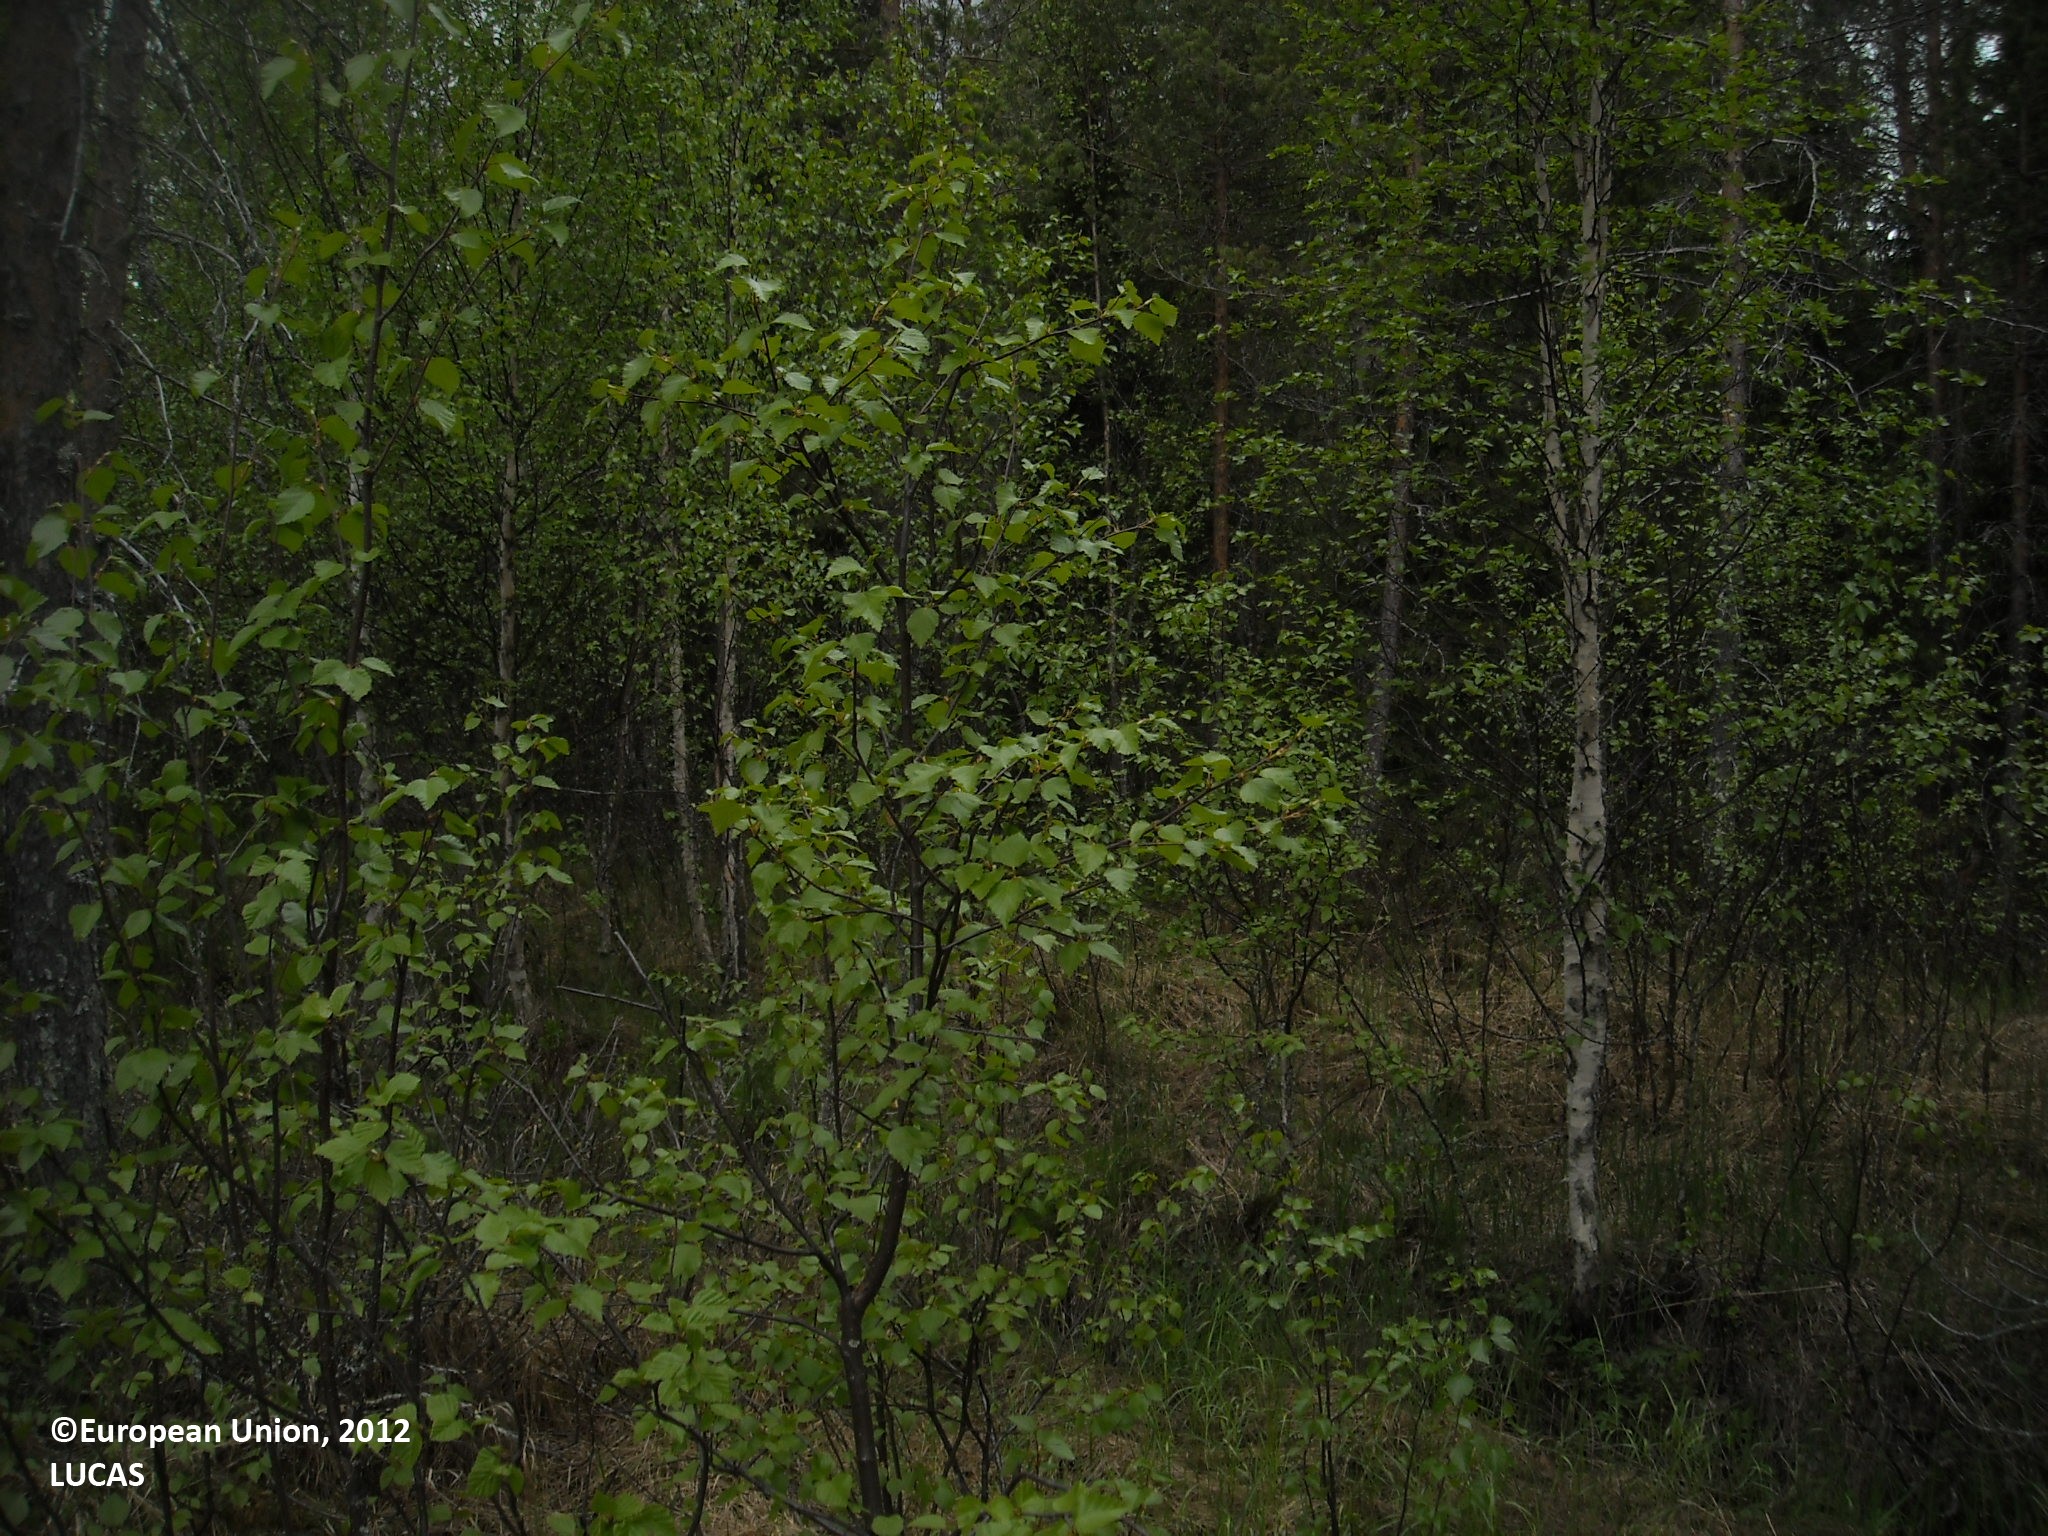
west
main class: Woodland
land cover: Pine dominated mixed woodland
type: mire and swamp forests
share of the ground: > 75 %
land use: Forestry
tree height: > 5 m
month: June
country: FI
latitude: 65.3294
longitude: 27.8566
